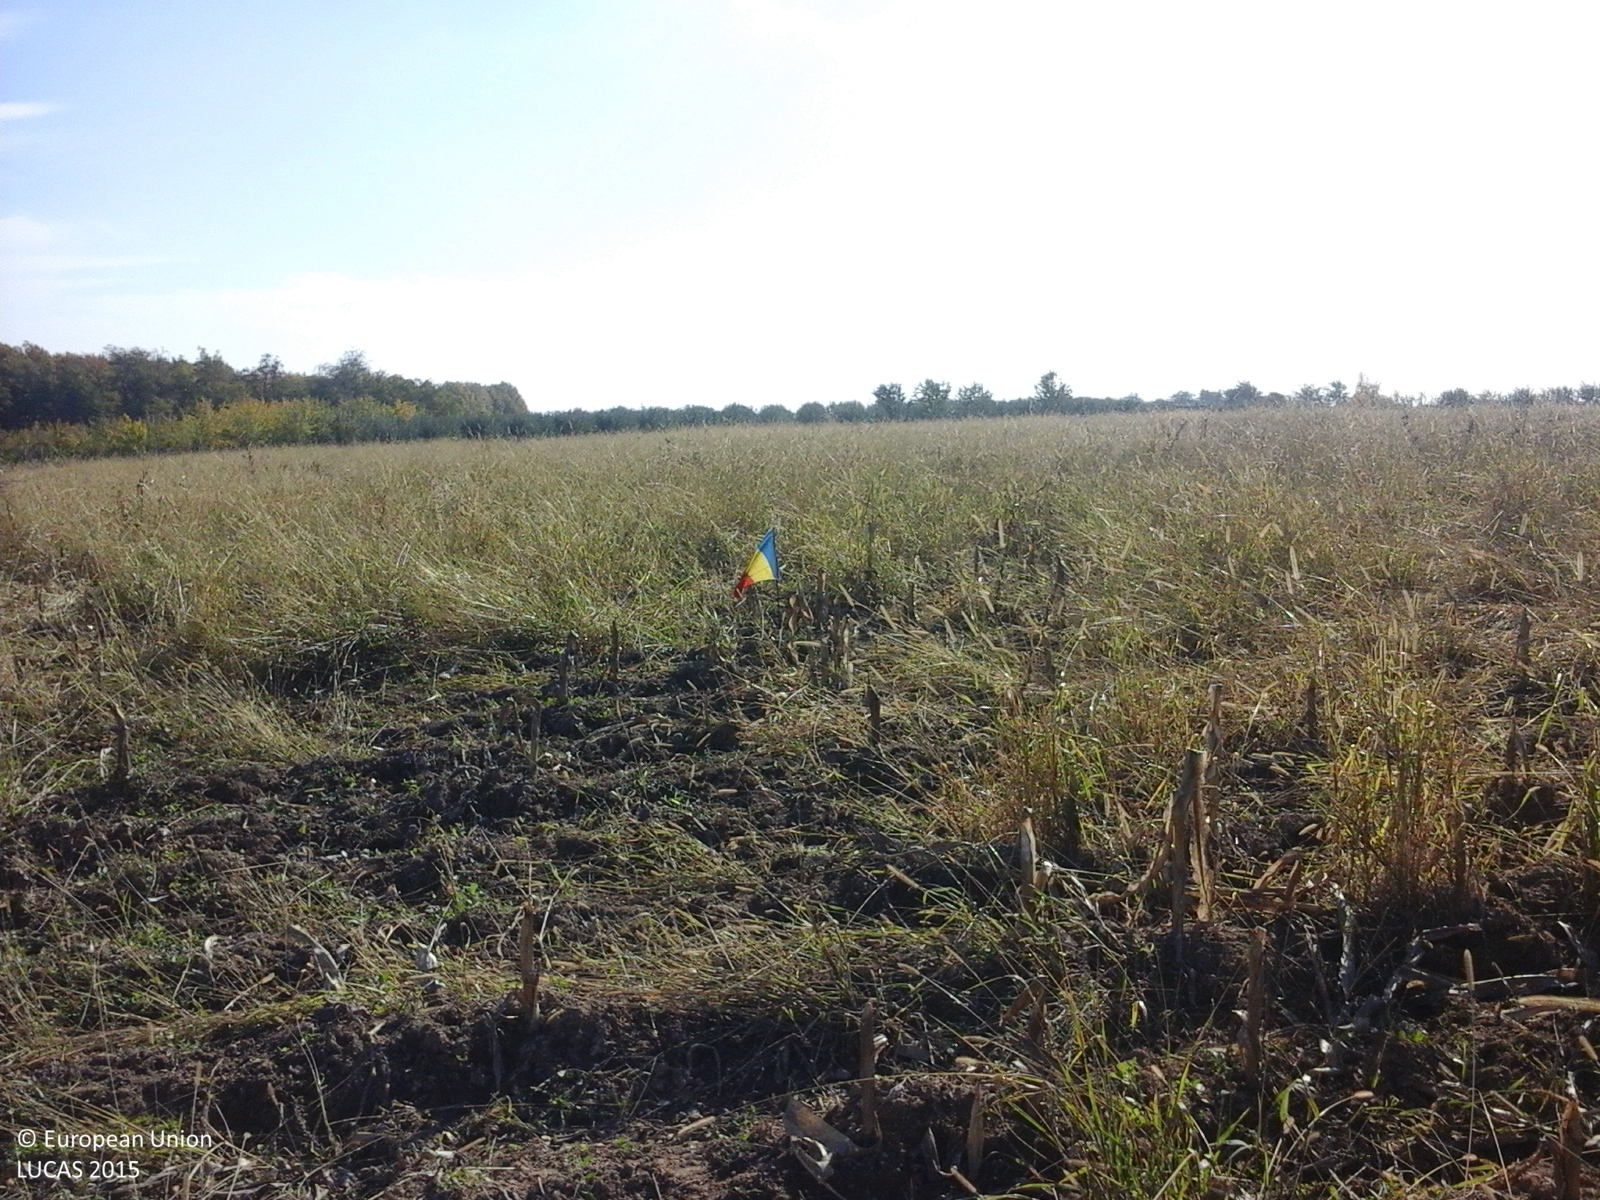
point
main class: Cropland
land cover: Maize
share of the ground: 25 - 50 %
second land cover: Spontaneously vegetated surfaces
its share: > 75 %
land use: Agriculture (excluding fallow land and kitchen gardens)
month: October
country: RO
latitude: 45.9956
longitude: 27.0726
